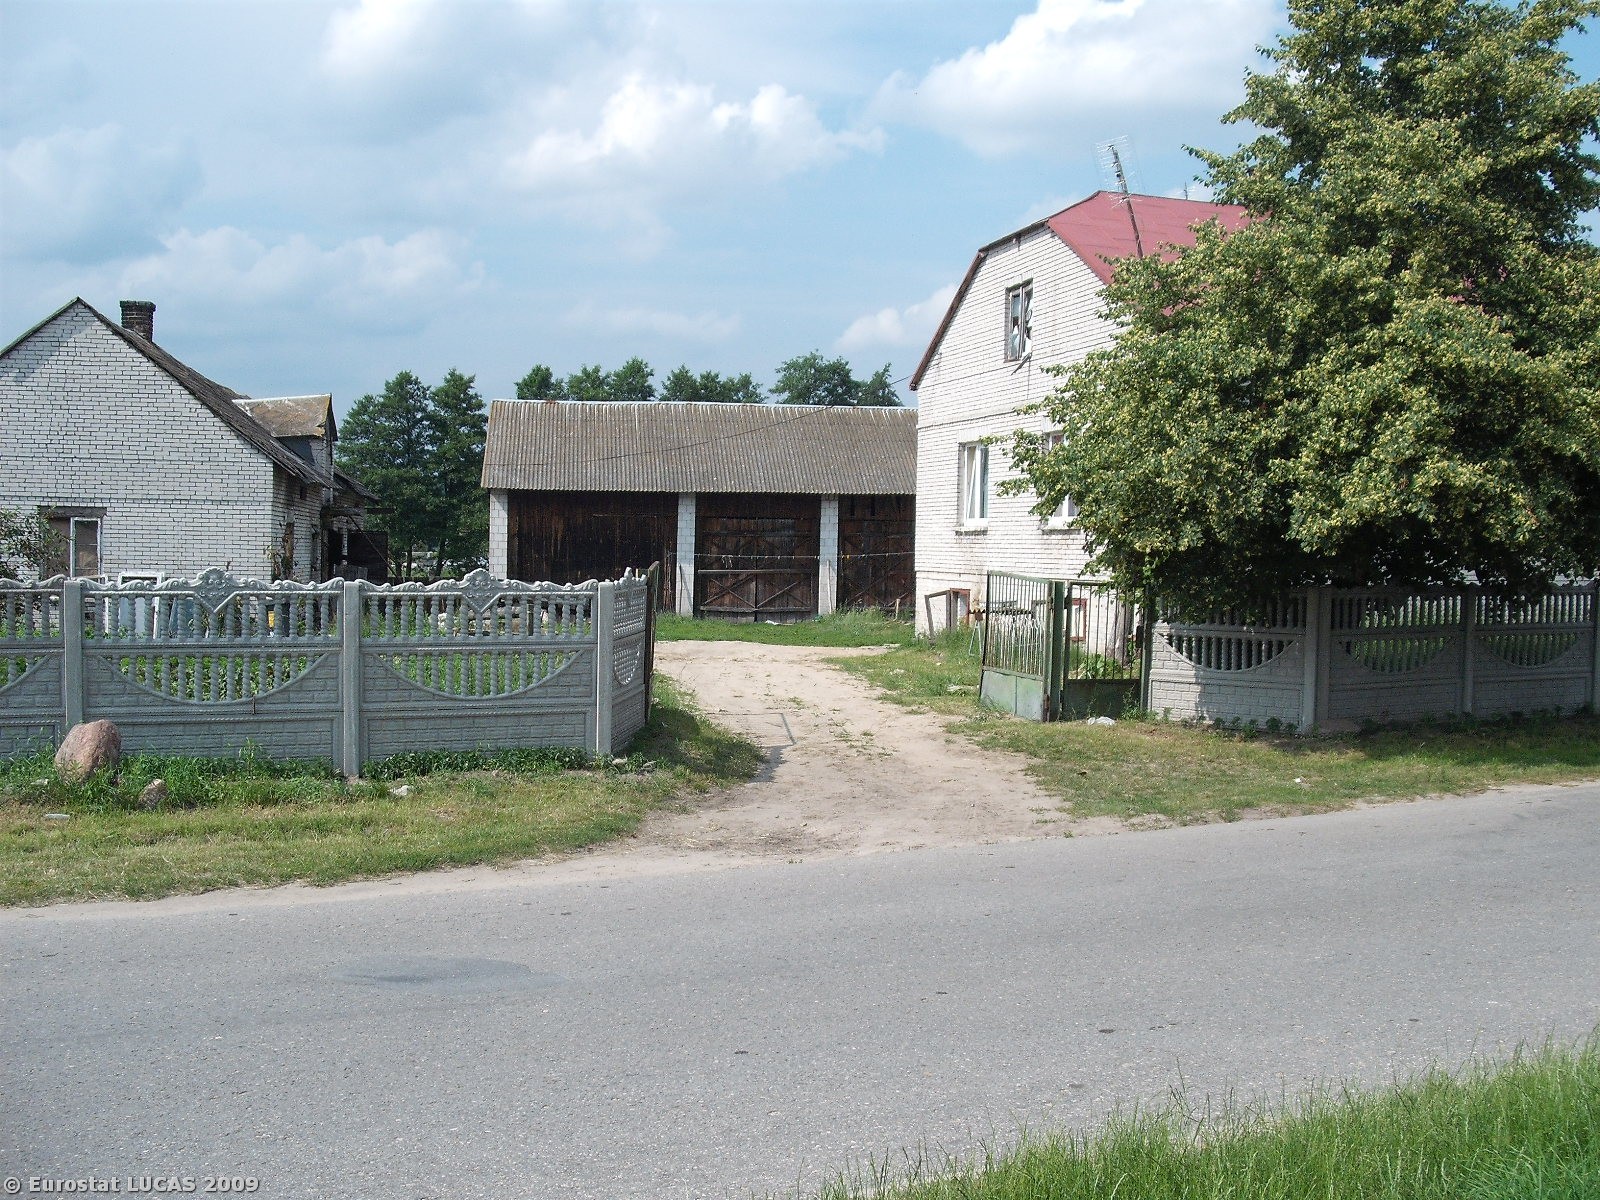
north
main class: Grassland
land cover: Spontaneously vegetated surfaces
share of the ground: > 75 %
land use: Unused
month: July
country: PL
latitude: 51.5506
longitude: 20.6690
